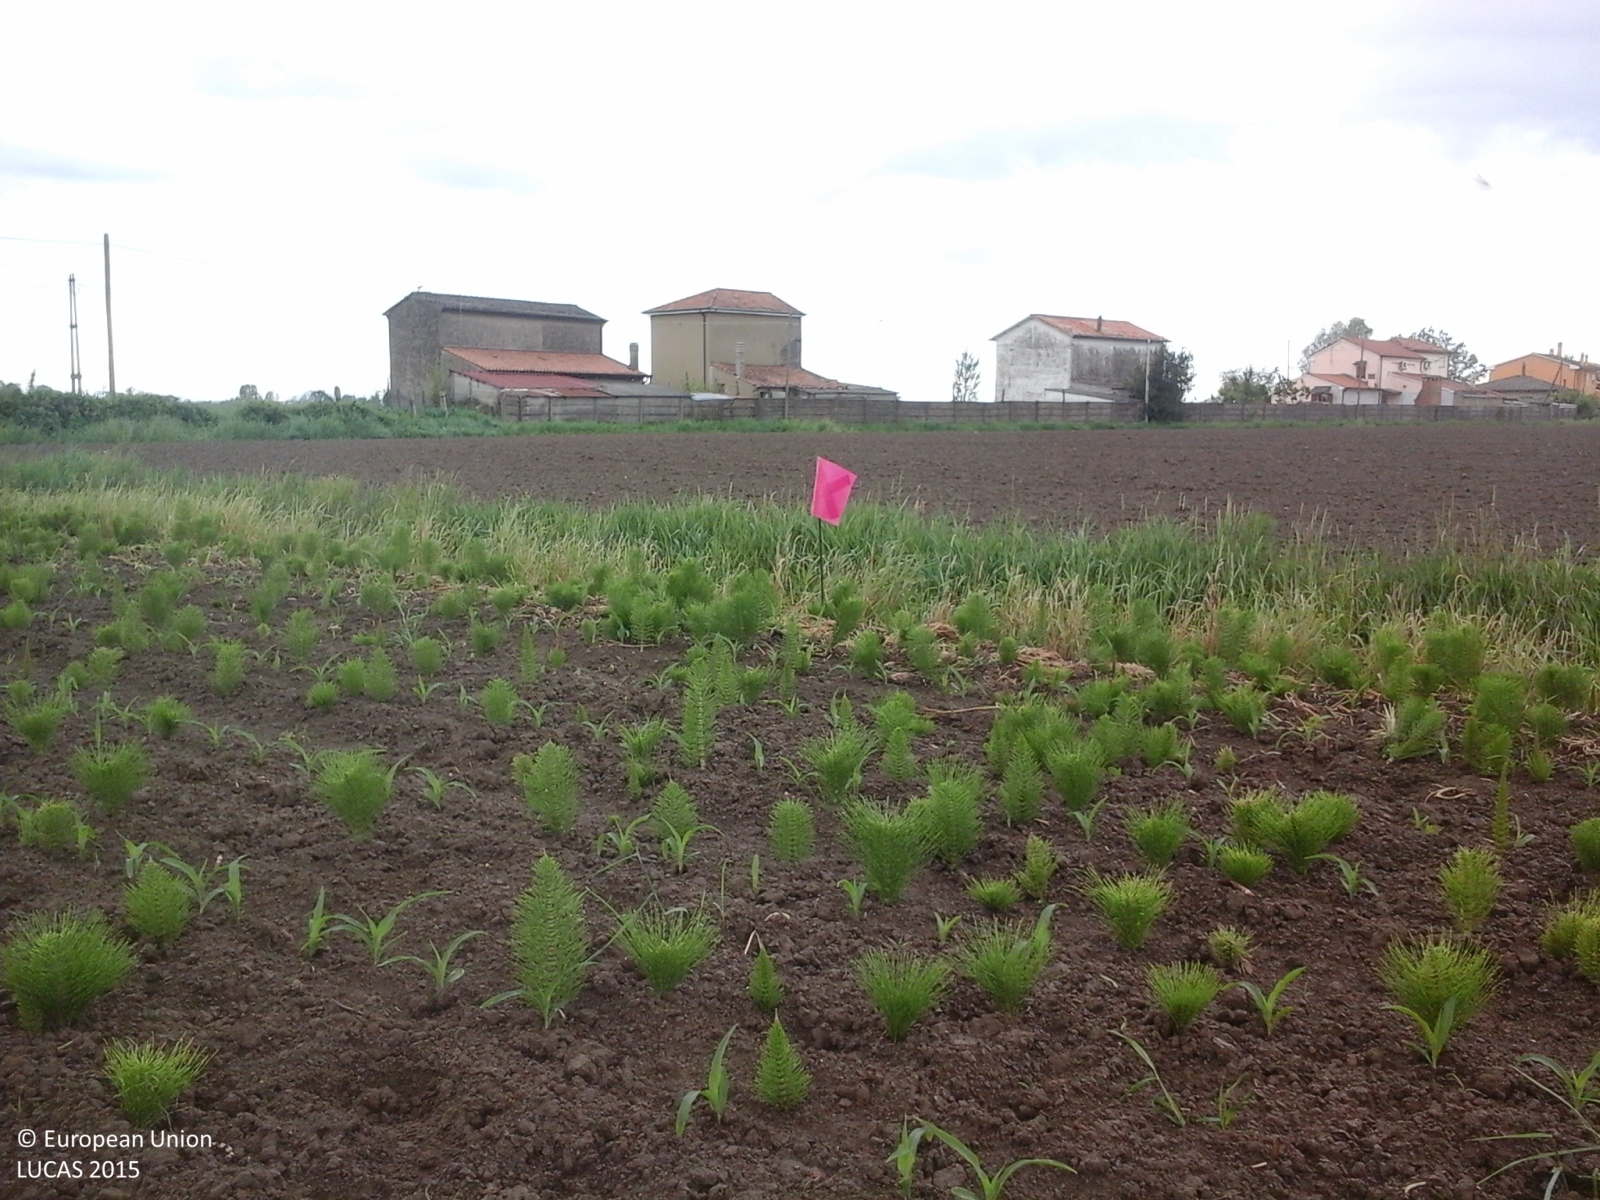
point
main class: Cropland
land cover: Maize
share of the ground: < 10 %
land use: Agriculture (excluding fallow land and kitchen gardens)
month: April
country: IT
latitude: 45.0034
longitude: 11.7348
